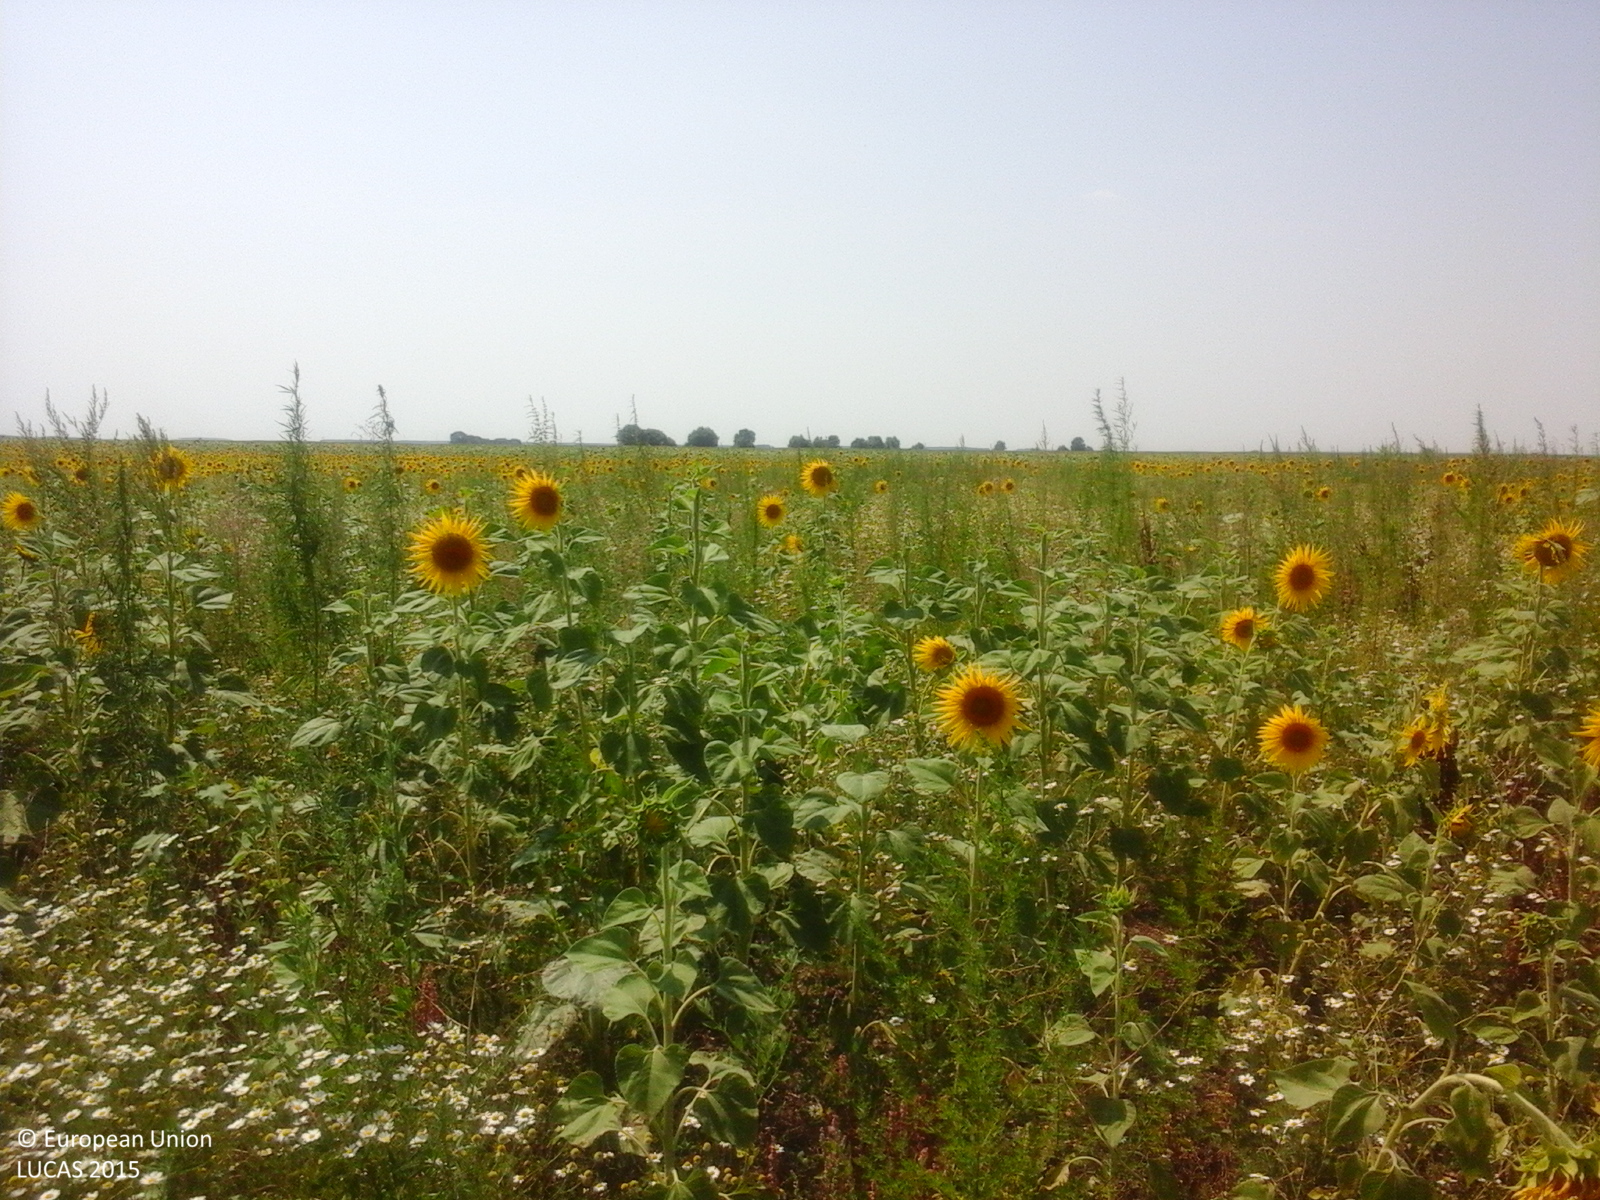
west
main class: Cropland
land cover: Sunflower
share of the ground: 50 - 75 %
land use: Agriculture (excluding fallow land and kitchen gardens)
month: July
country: RO
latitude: 44.5853
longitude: 28.0067
